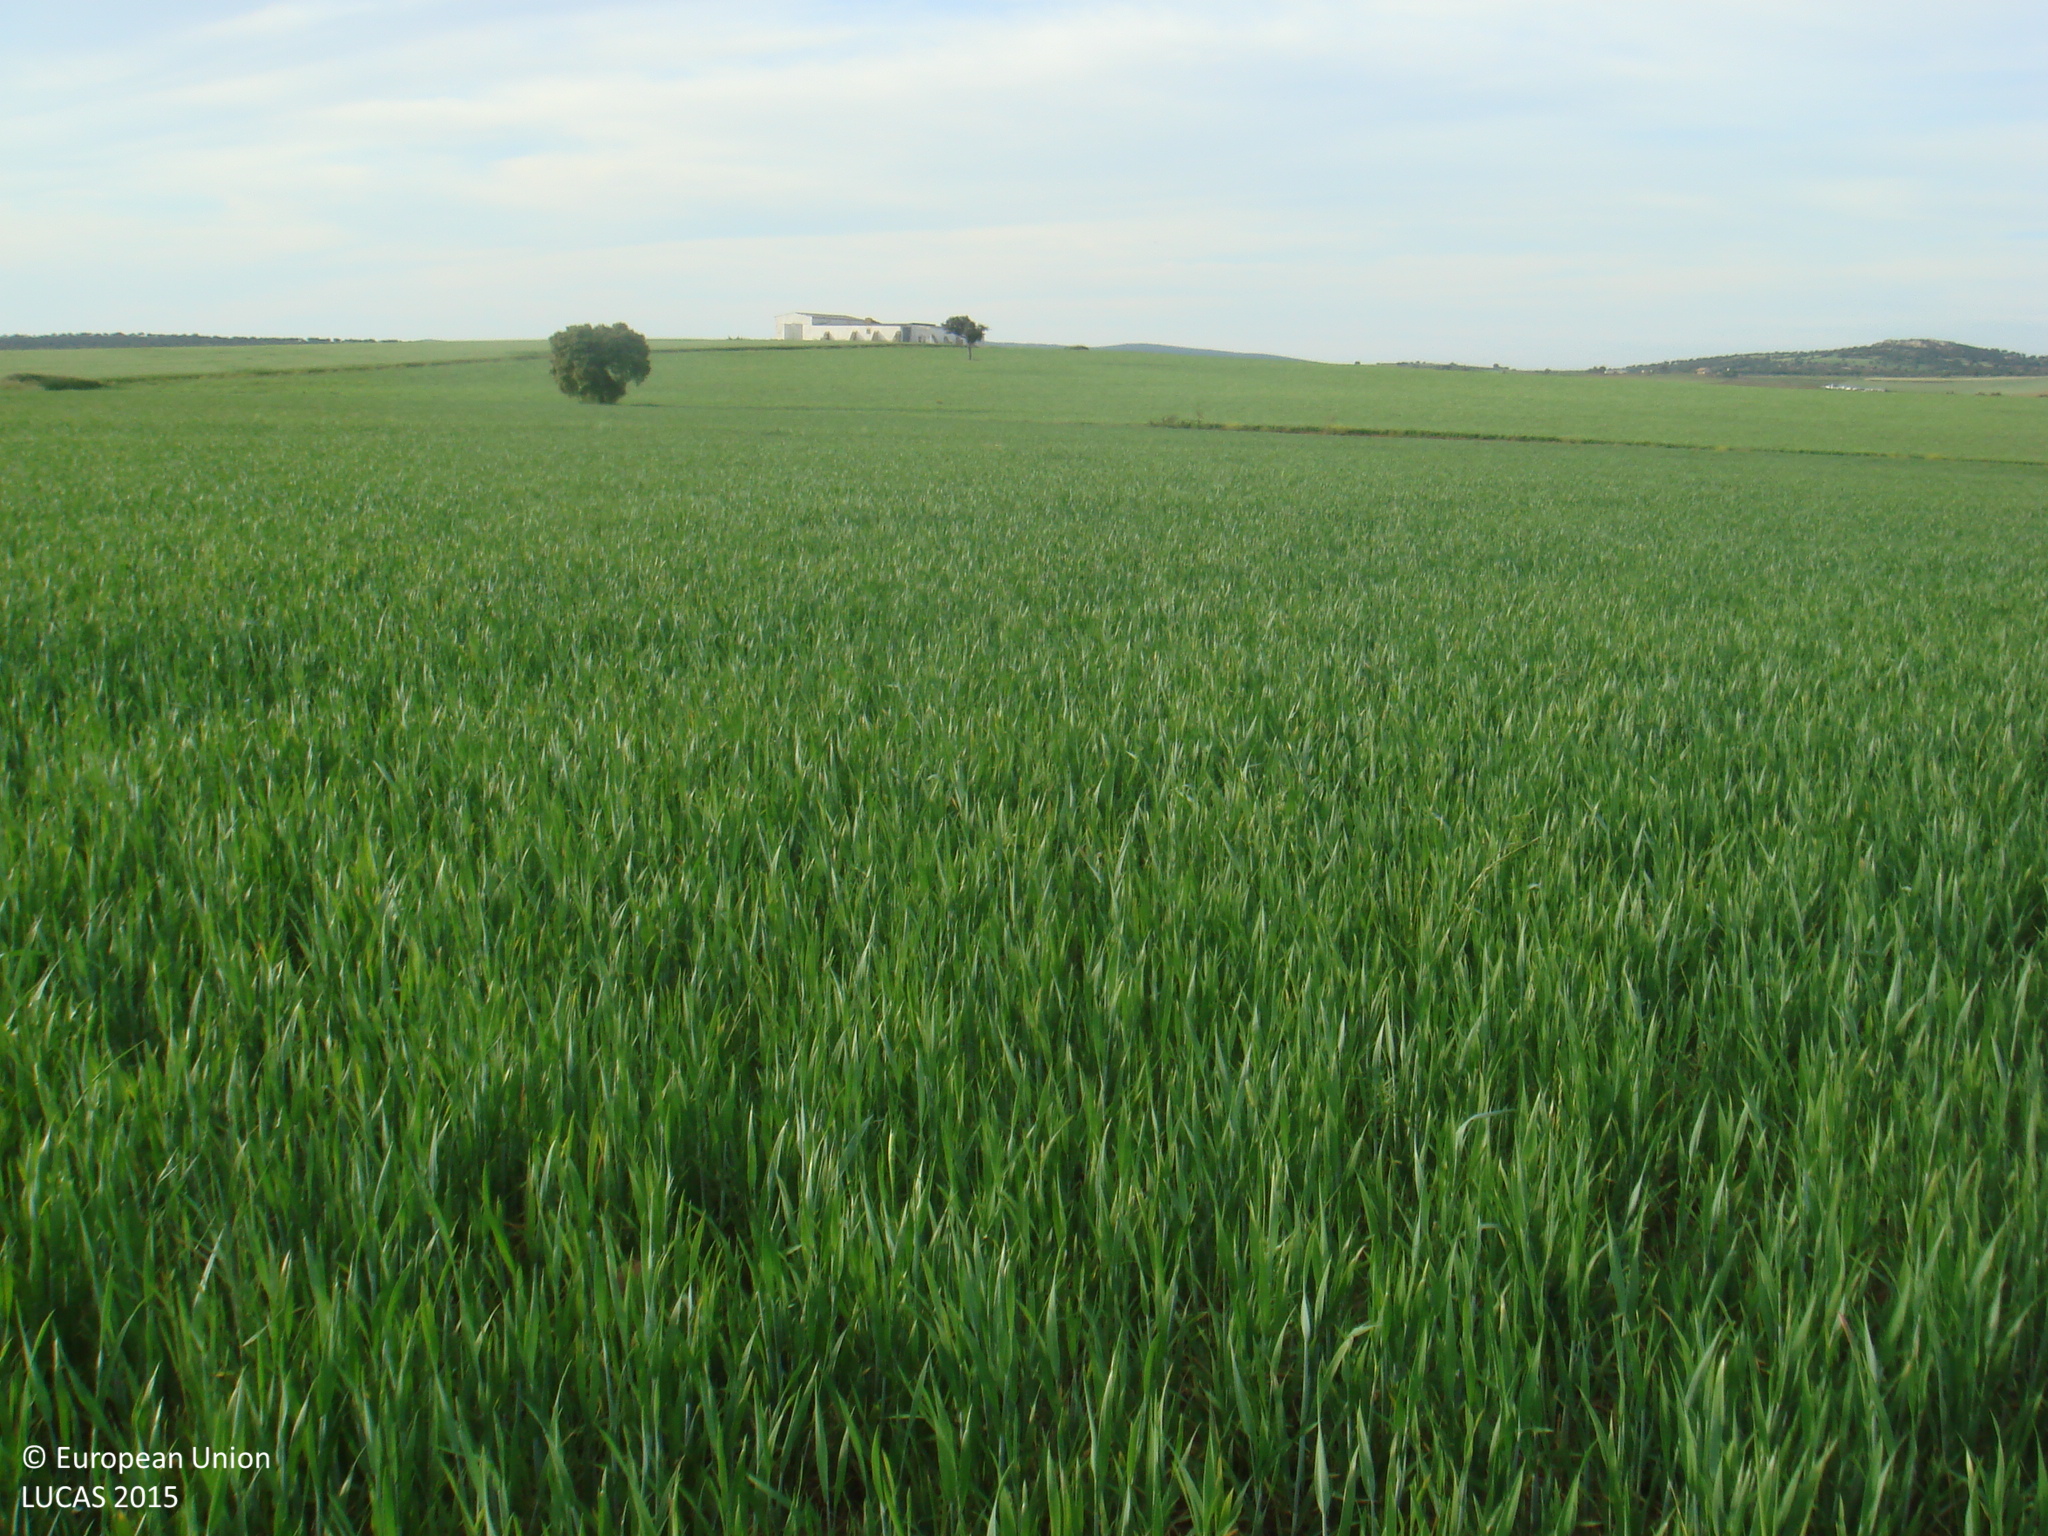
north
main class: Cropland
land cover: Durum wheat
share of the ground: > 75 %
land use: Agriculture (excluding fallow land and kitchen gardens)
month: April
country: ES
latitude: 38.3521
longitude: -5.3527
